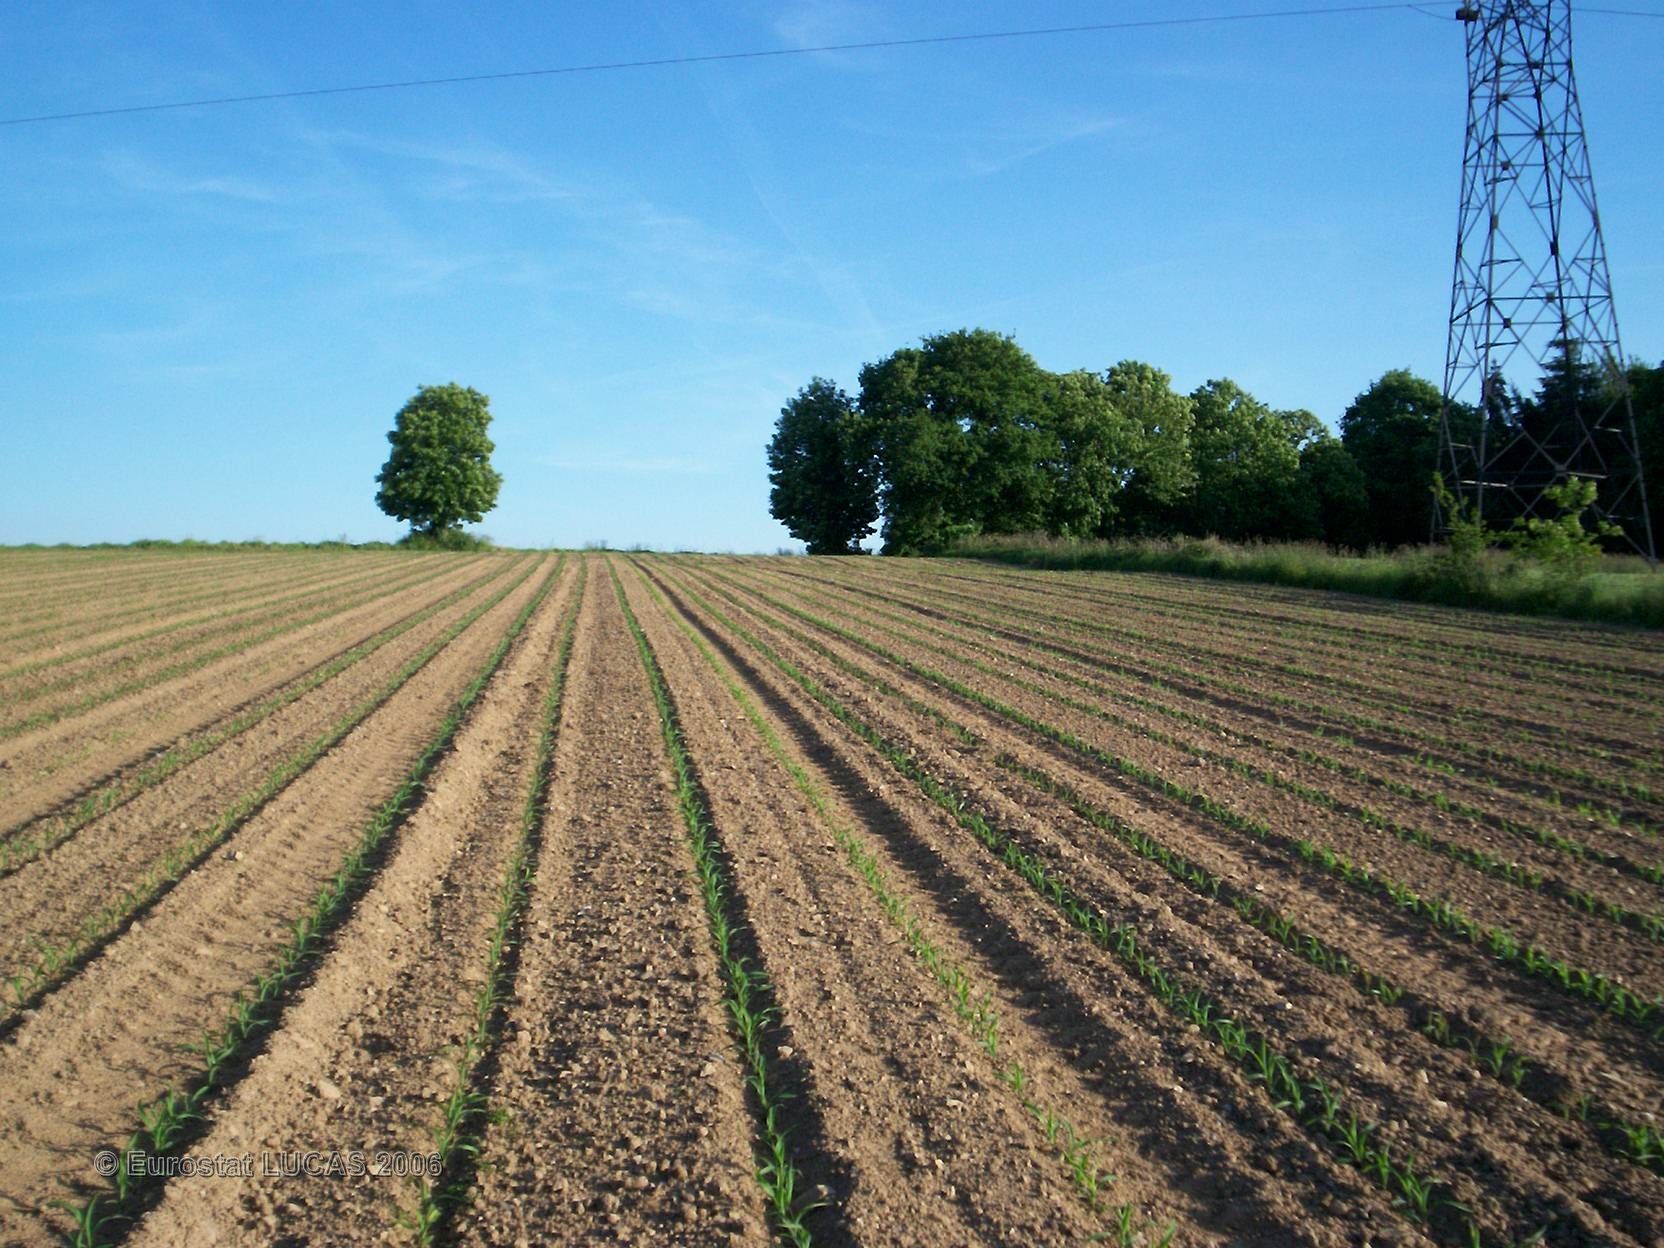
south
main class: Cropland
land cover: Maize
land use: Agriculture (excluding fallow land and kitchen gardens)
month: June
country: FR
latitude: 48.5067
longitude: -1.7039
